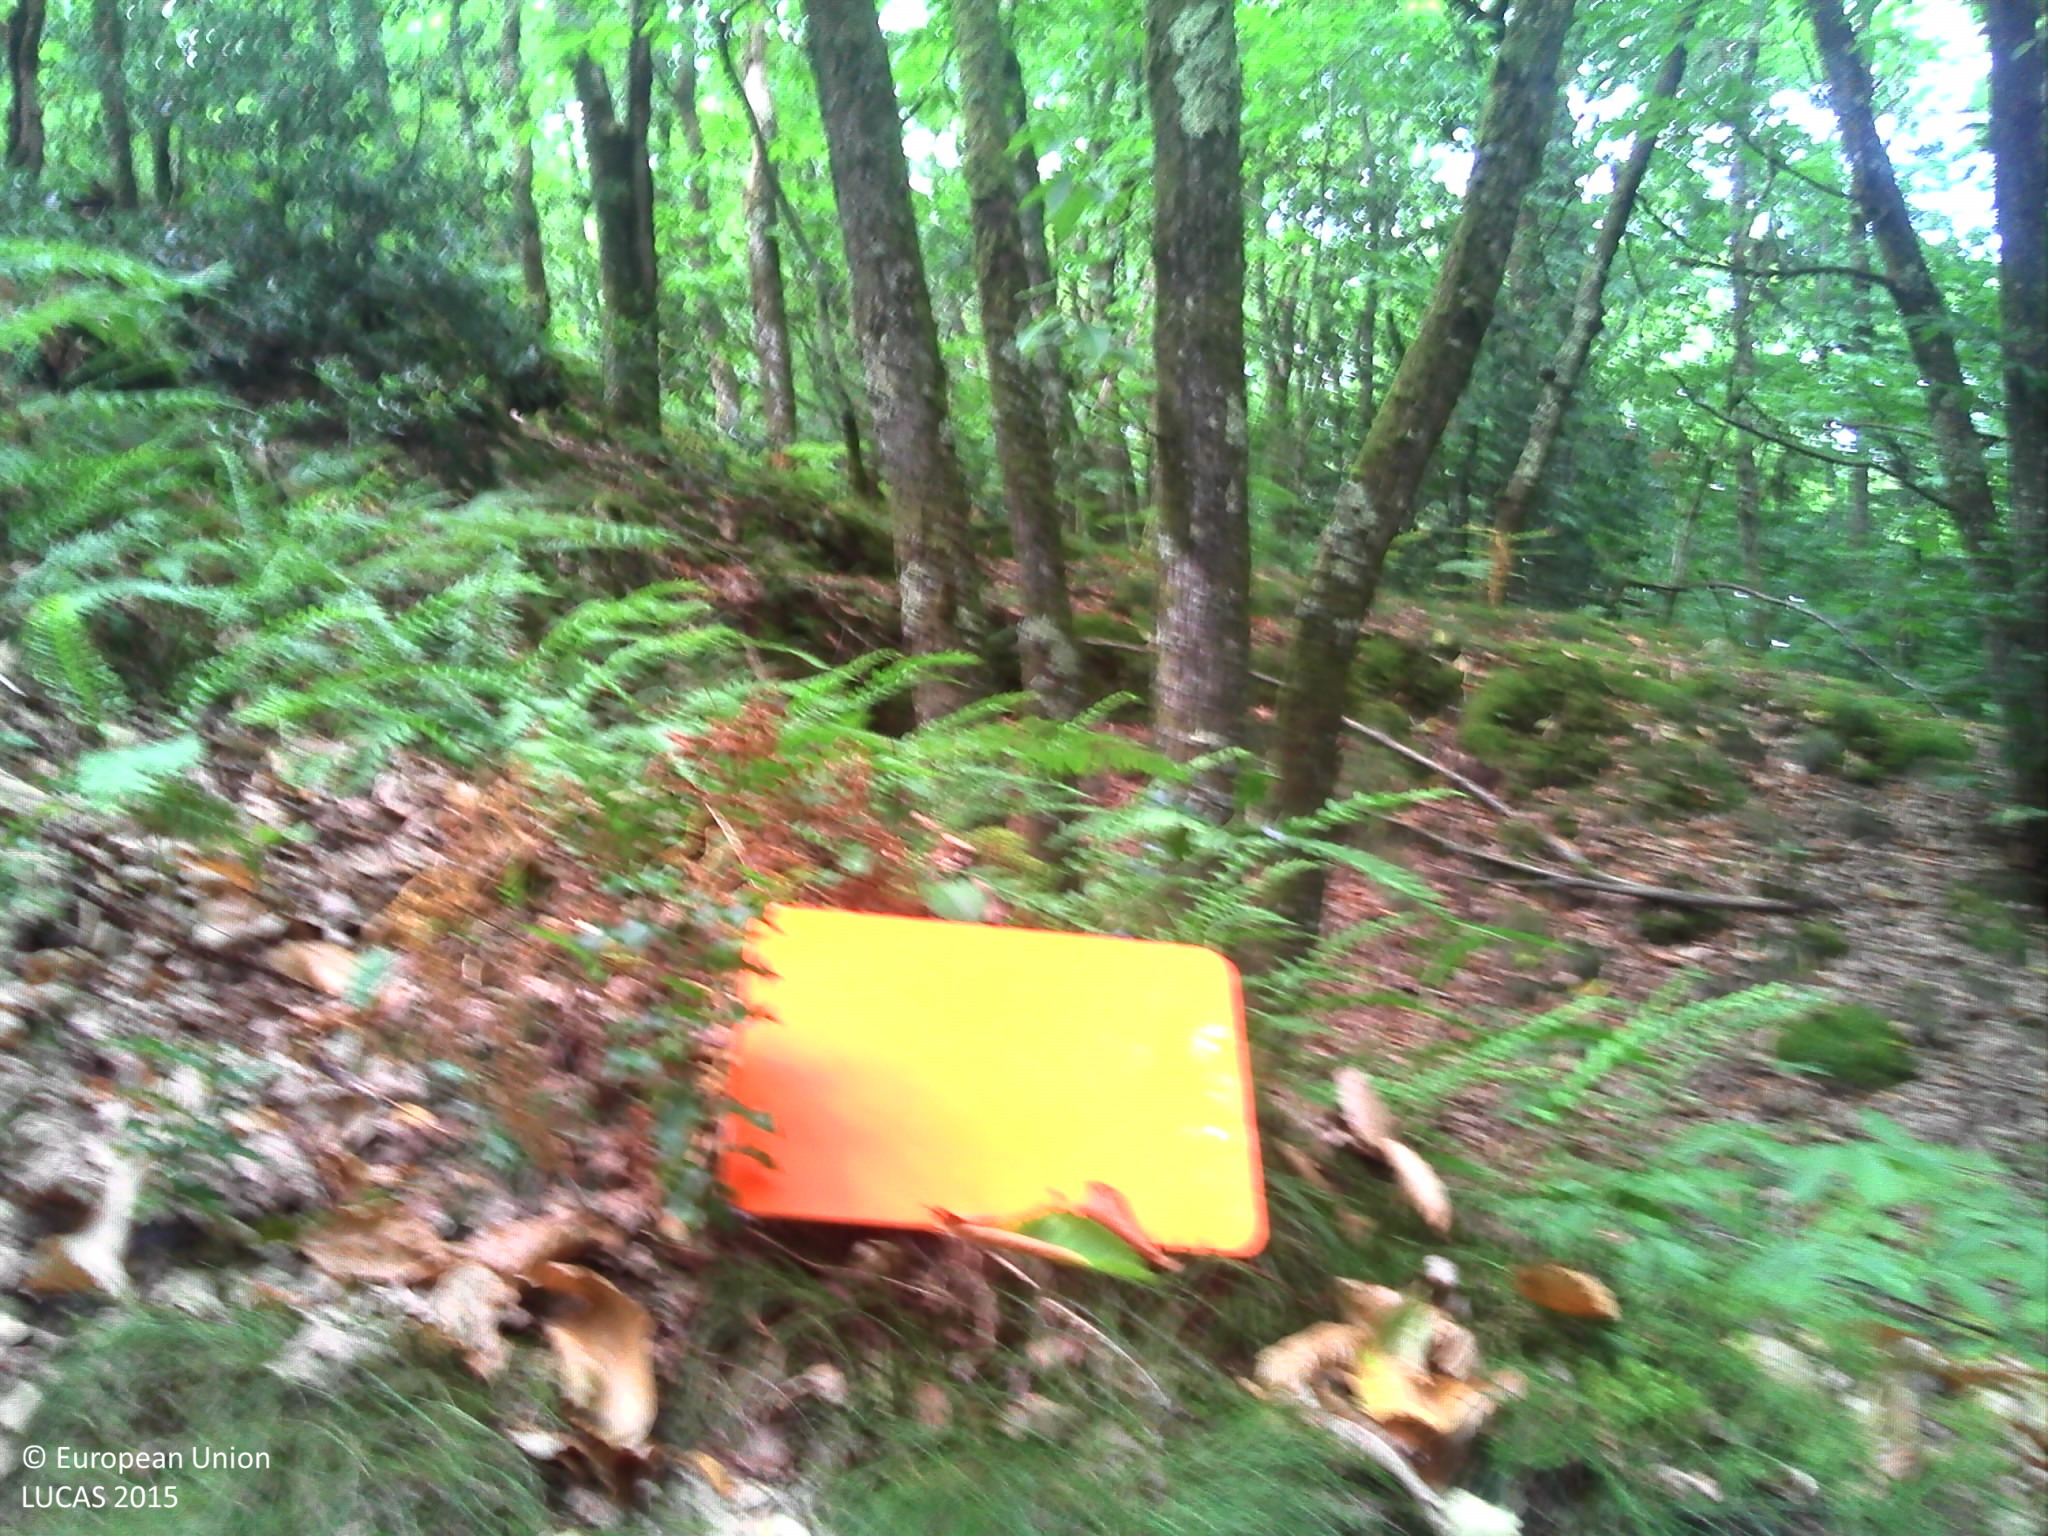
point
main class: Woodland
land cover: Broadleaved woodland
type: acidophilous oak and oak-birch forest
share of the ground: > 75 %
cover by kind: broadleaved forest trees 80 %, shrubs 10 %, herbaceous plants 5 %, lichens and mosses 5 %
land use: Forestry
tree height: > 5 m
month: August
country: FR
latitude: 46.2835
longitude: 1.7243
